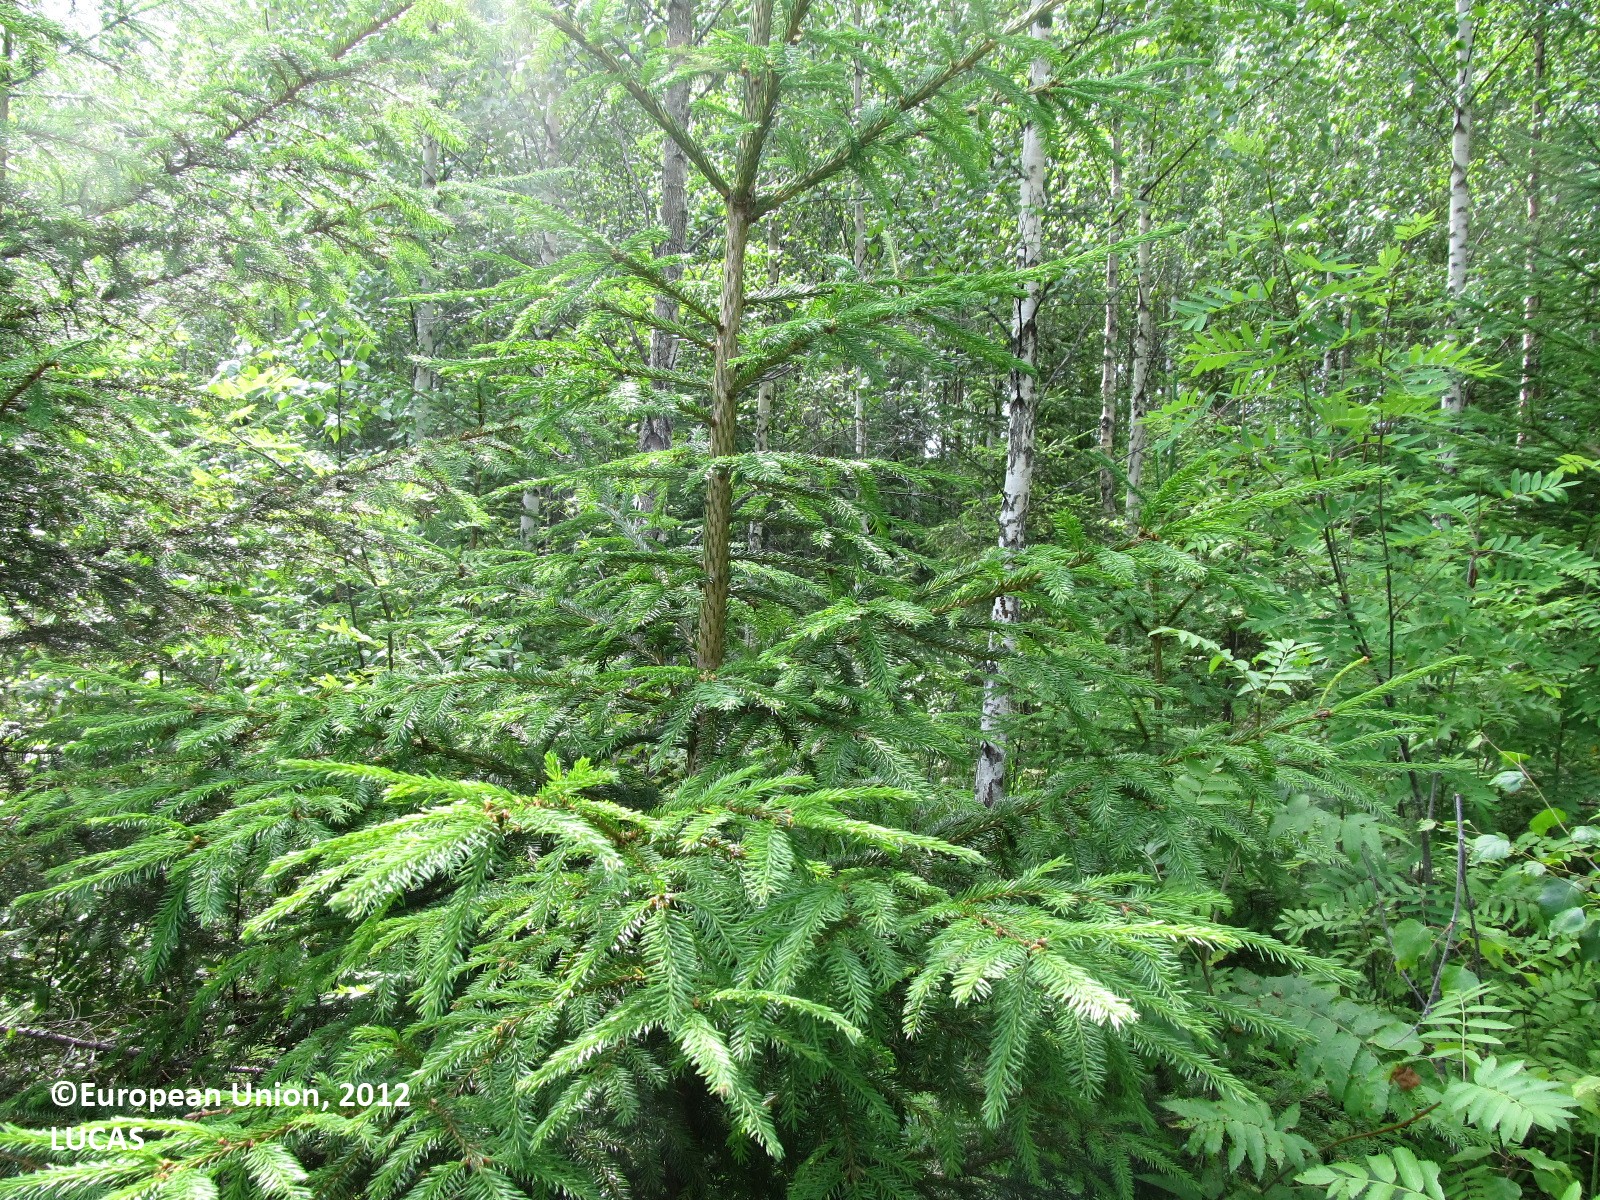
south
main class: Woodland
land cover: Pine dominated mixed woodland
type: boreal forest
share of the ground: 25 - 50 %
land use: Forestry
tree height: < 5 m
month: July
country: FI
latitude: 61.9286
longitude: 29.1081
